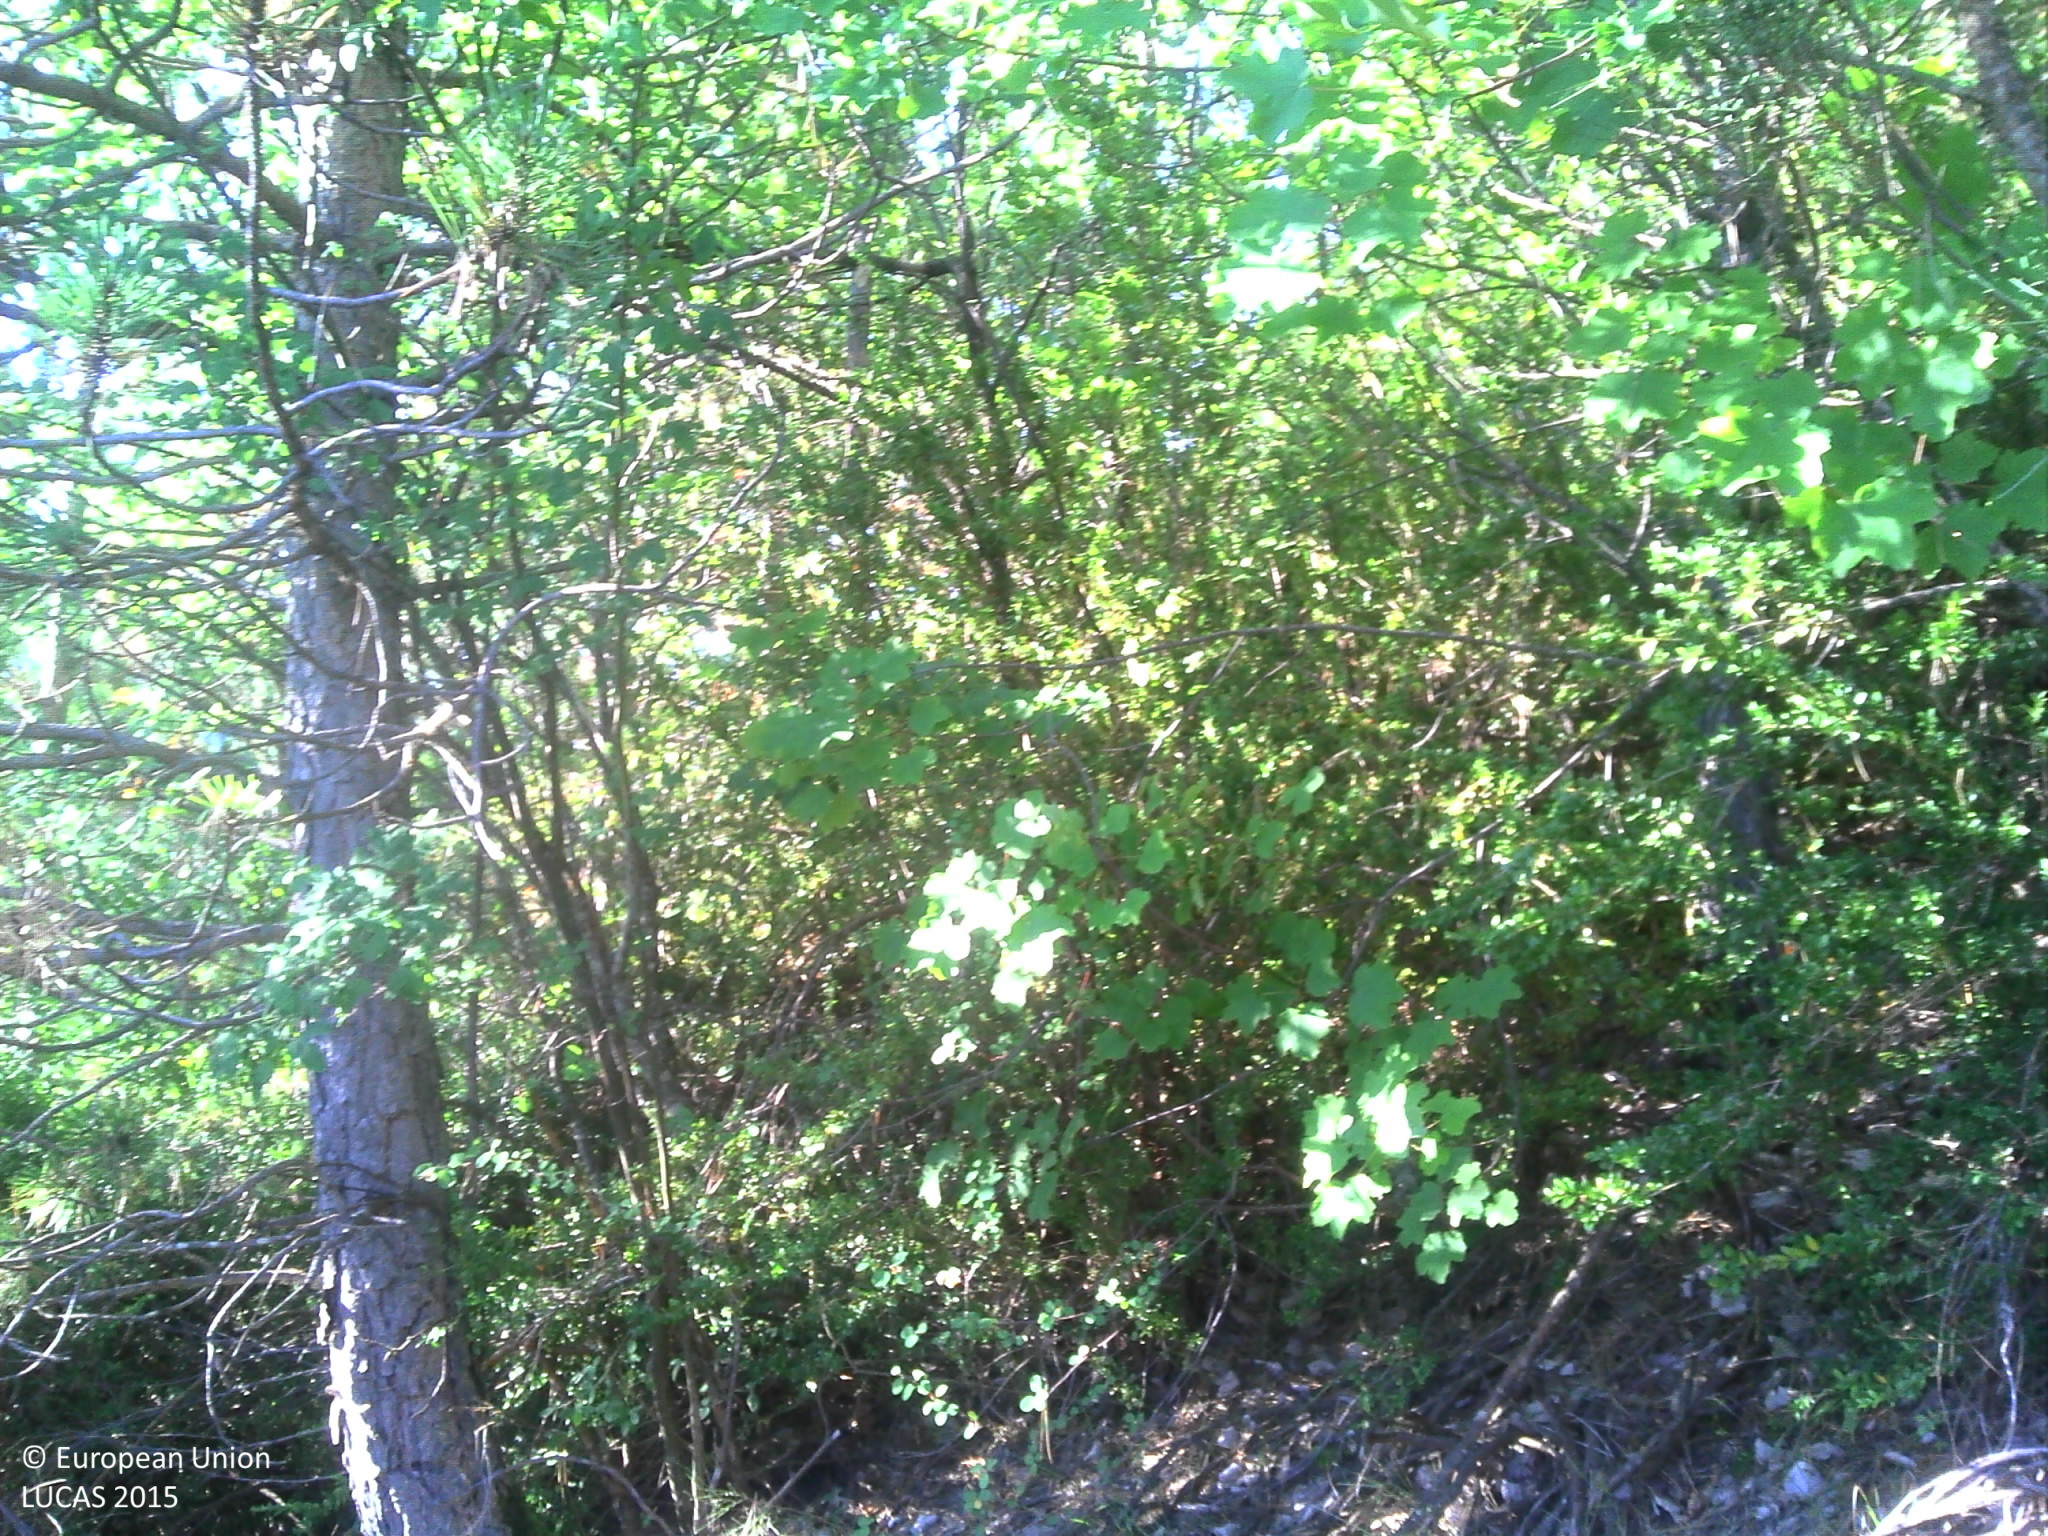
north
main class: Woodland
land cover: Pine dominated mixed woodland
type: coniferous forest of the mediterranean region
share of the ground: > 75 %
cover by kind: coniferous forest trees 50 %, broadleaved forest trees 25 %, herbaceous plants 15 %, unconsolidated bare surface 10 %
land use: Forestry
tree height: > 5 m
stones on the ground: 10 - 25 %
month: August
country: FR
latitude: 44.2147
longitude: 6.3649
